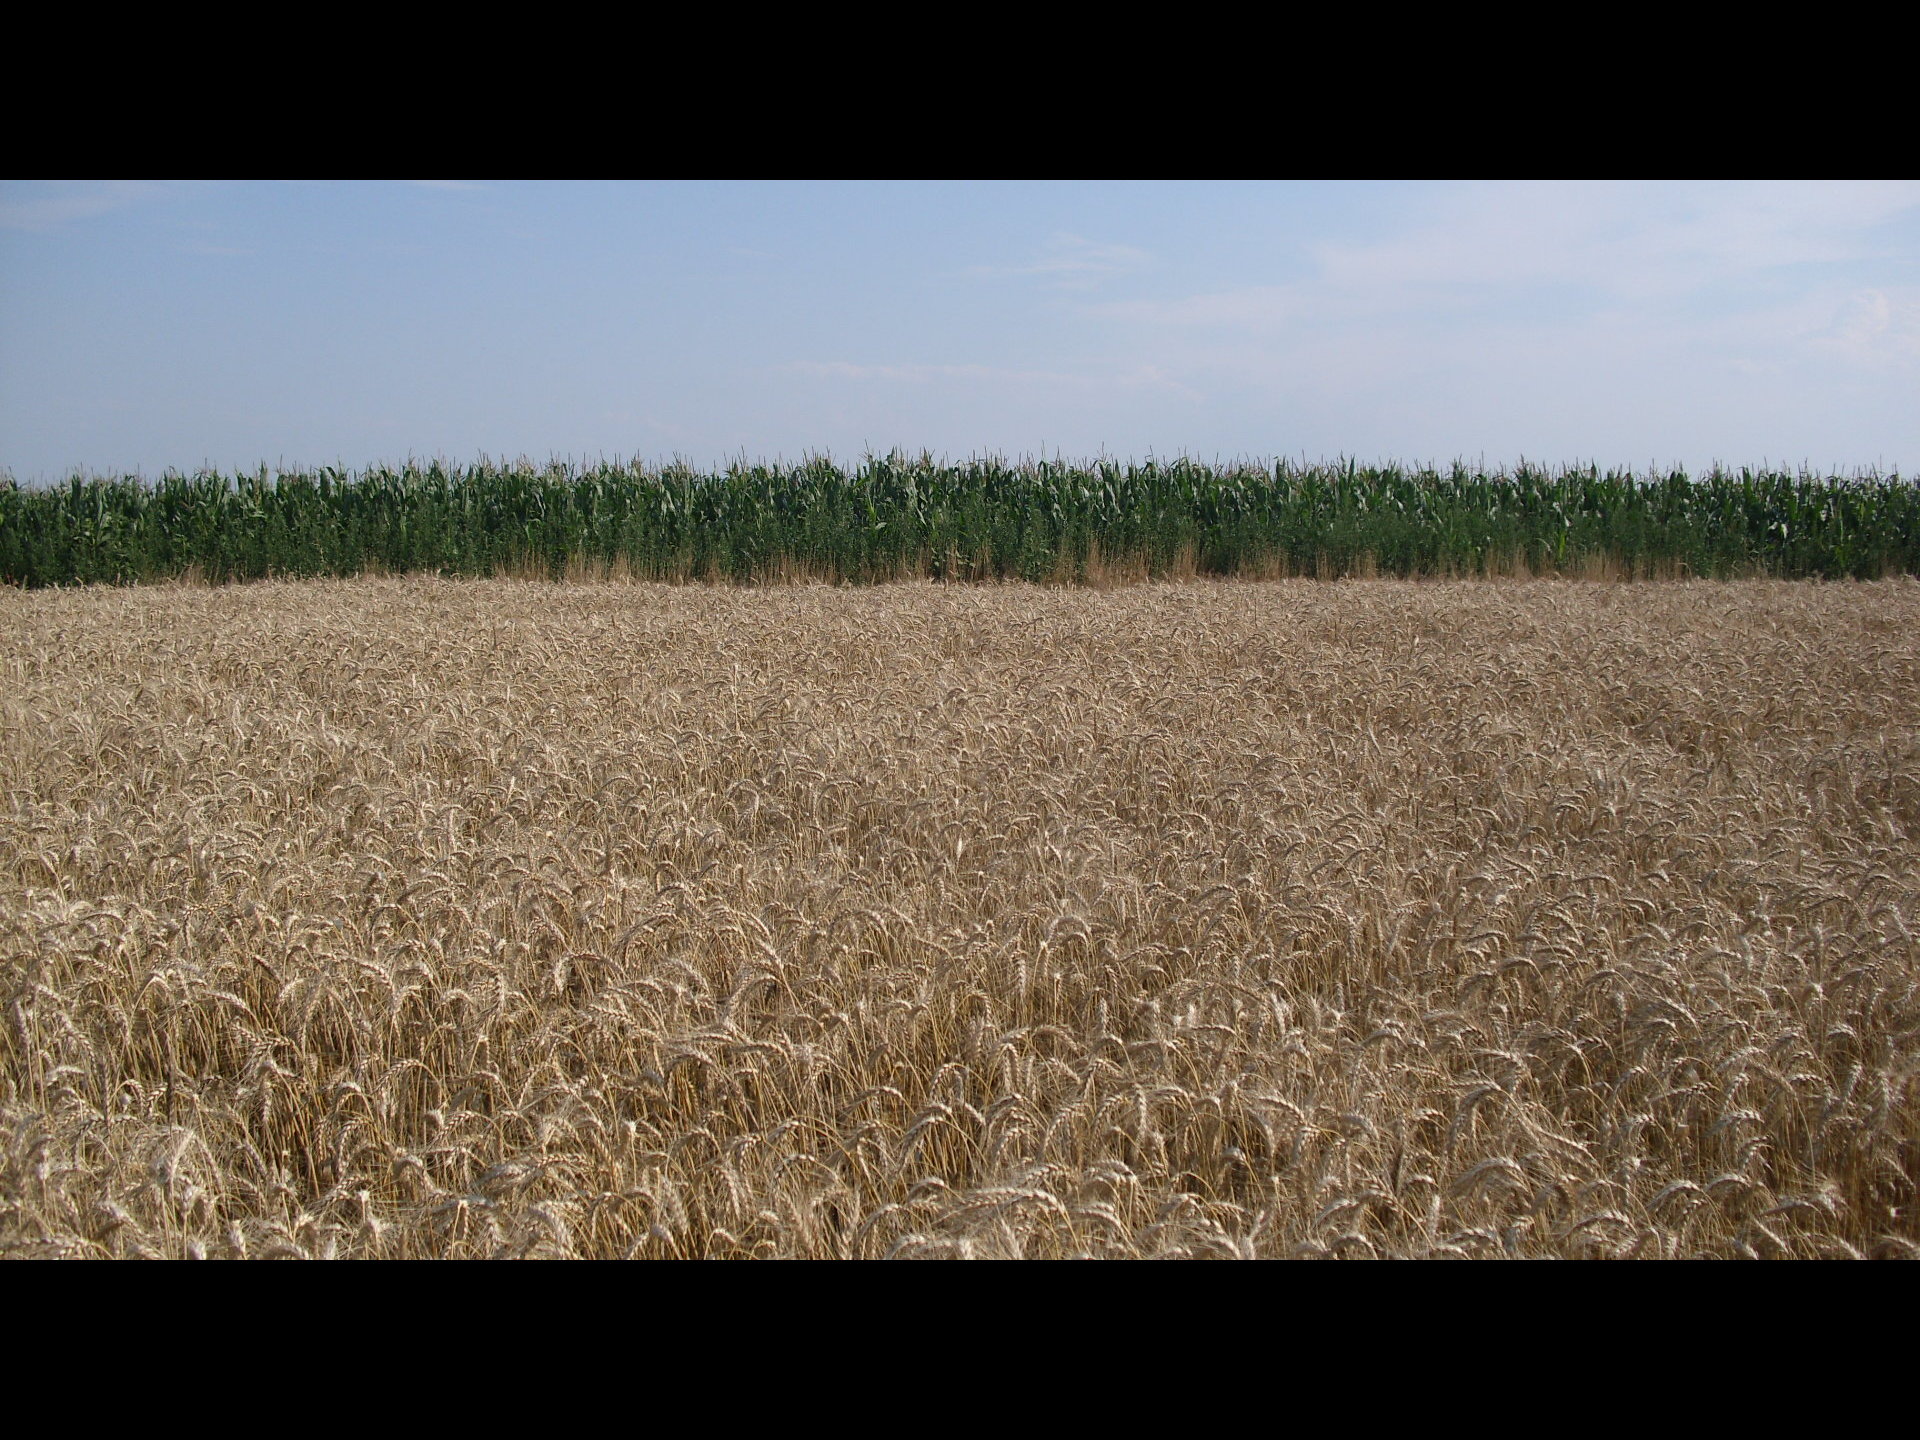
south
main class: Cropland
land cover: Common wheat
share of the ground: > 75 %
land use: Agriculture (excluding fallow land and kitchen gardens)
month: June
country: BG
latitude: 43.6661
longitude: 23.3507
